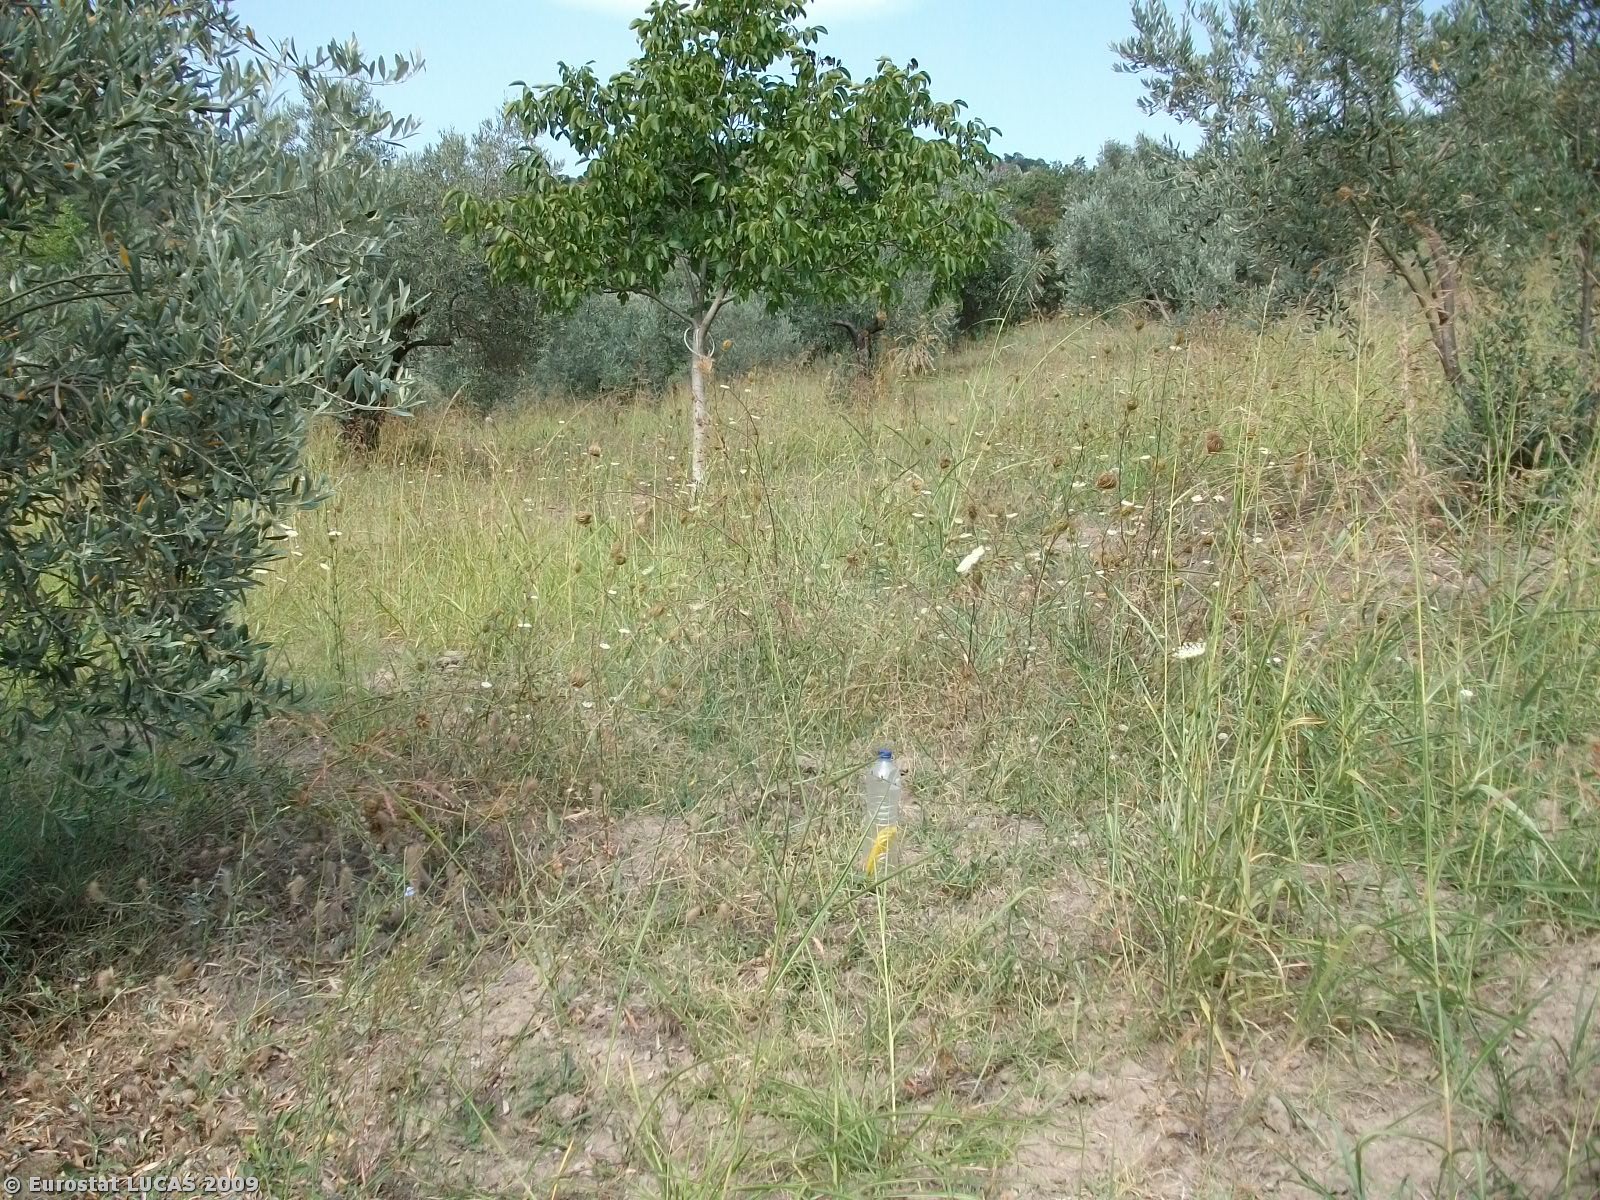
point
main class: Cropland
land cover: Olive groves
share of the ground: 25 - 50 %
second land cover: Grassland with sparse tree/shrub cover
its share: > 75 %
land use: Agriculture (excluding fallow land and kitchen gardens)
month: August
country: GR
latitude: 38.7645
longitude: 22.6751
